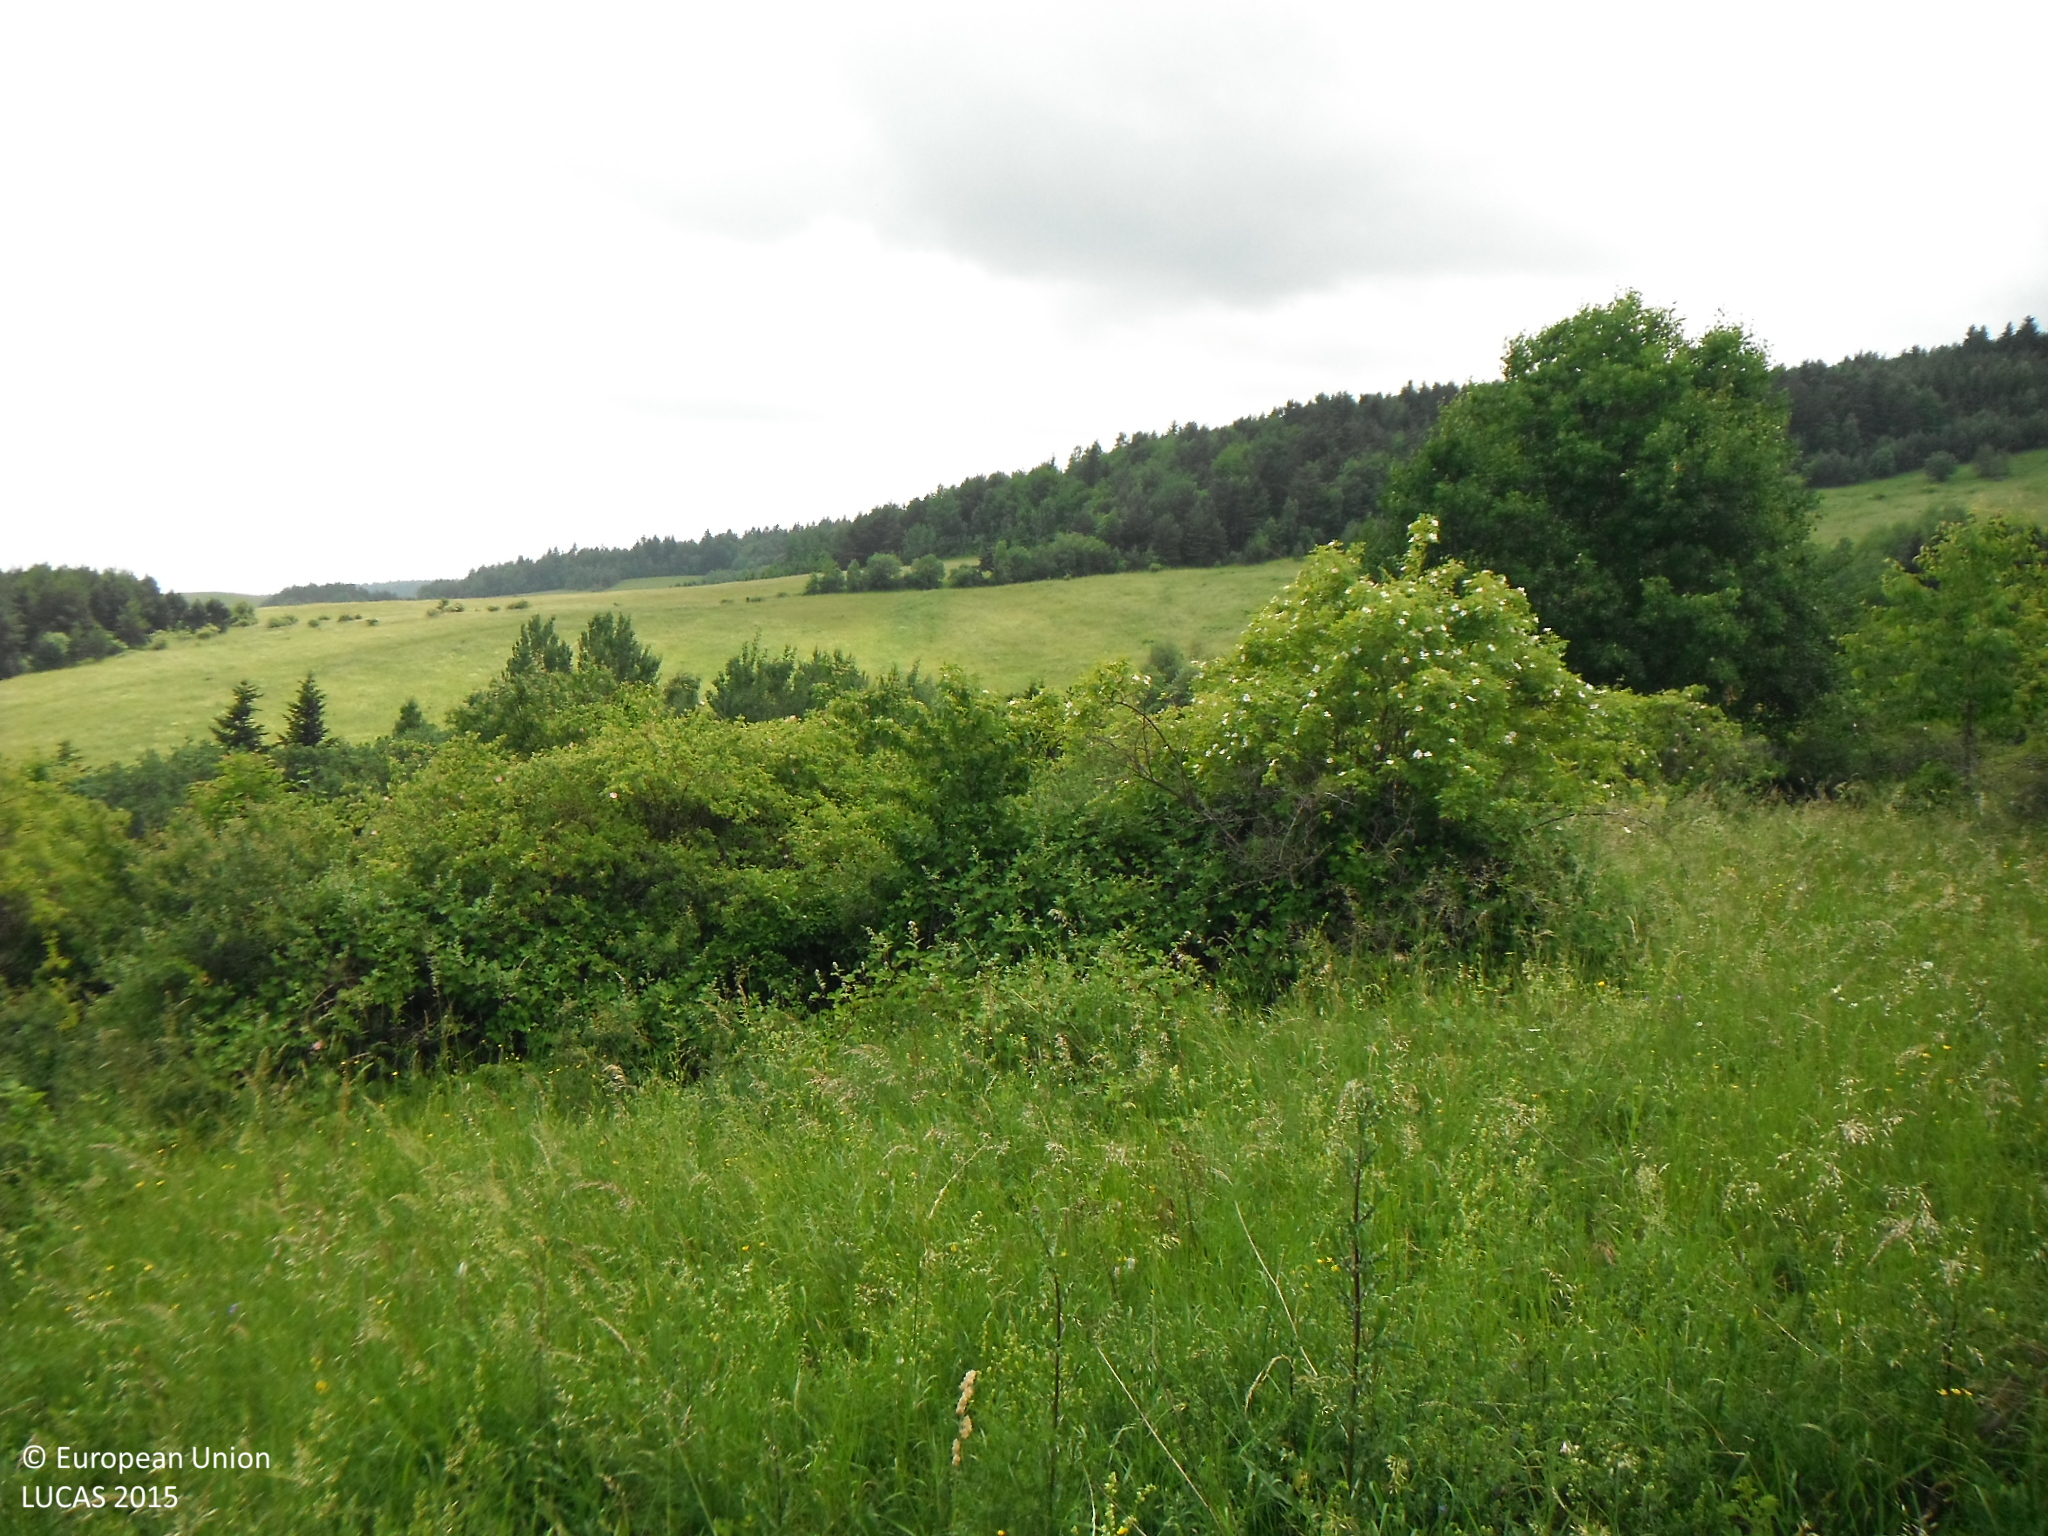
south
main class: Shrubland
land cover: Shrubland without tree cover
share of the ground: 50 - 75 %
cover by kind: shrubs 60 %, herbaceous plants 40 %
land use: Abandoned areas
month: June
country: SK
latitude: 49.1918
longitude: 21.2285
